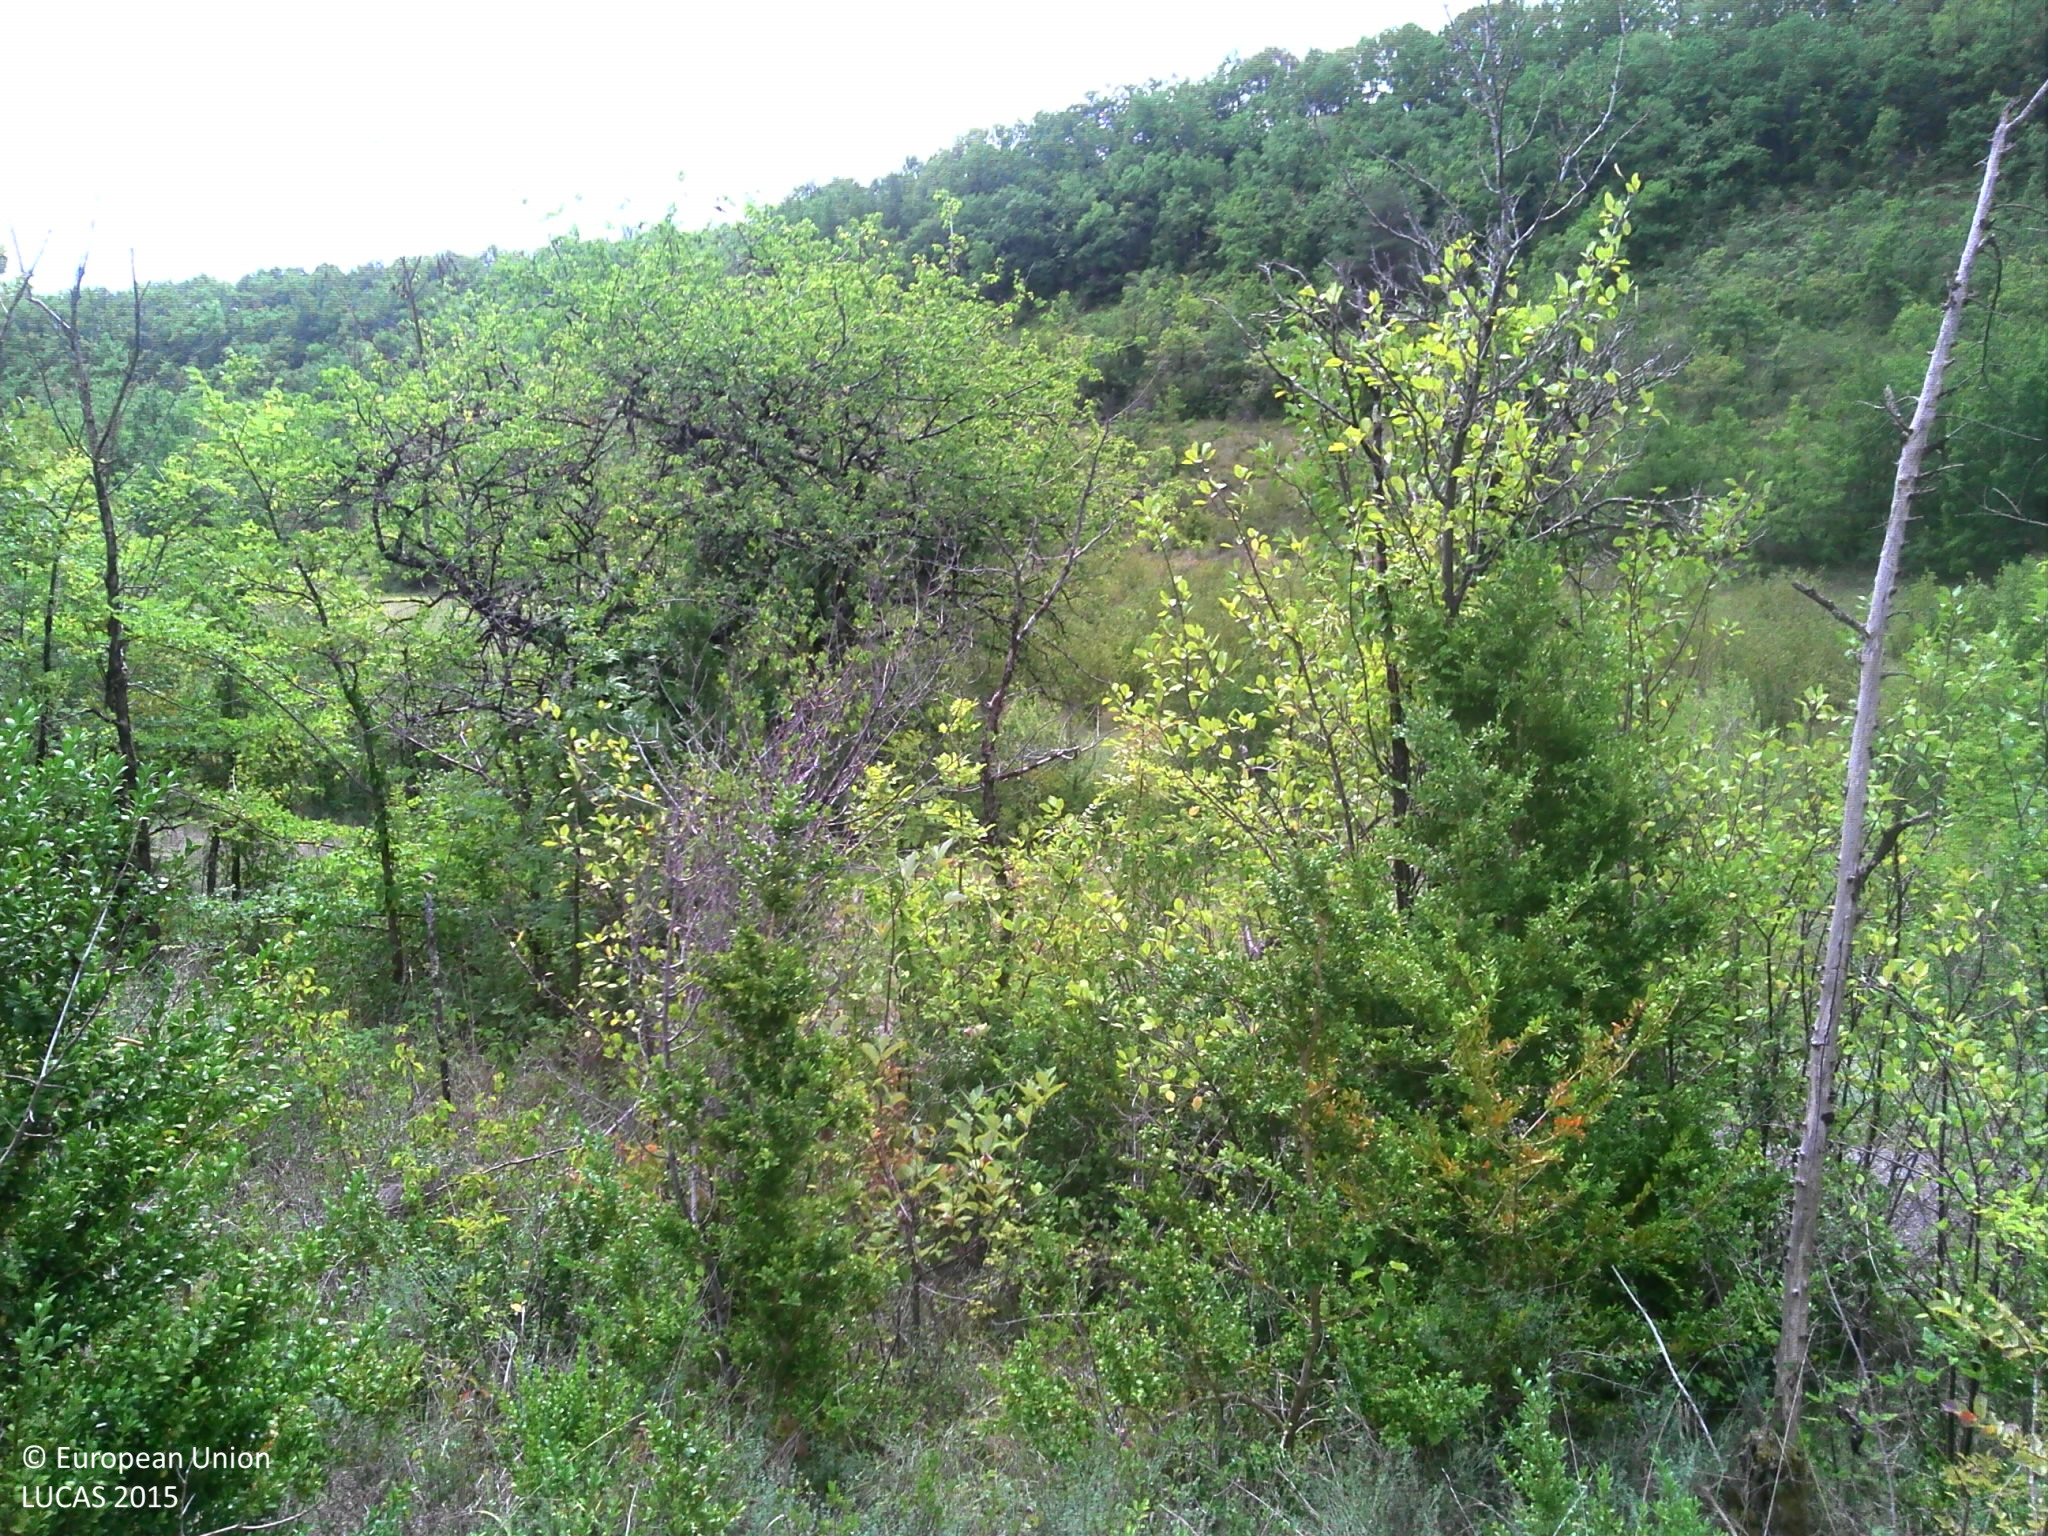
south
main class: Shrubland
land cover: Shrubland with sparse tree cover
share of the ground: > 75 %
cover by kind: shrubs 65 %, herbaceous plants 30 %, broadleaved forest trees 5 %
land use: Semi-natural and natural areas not in use
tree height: > 5 m
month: August
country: FR
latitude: 44.3476
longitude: 1.3047
